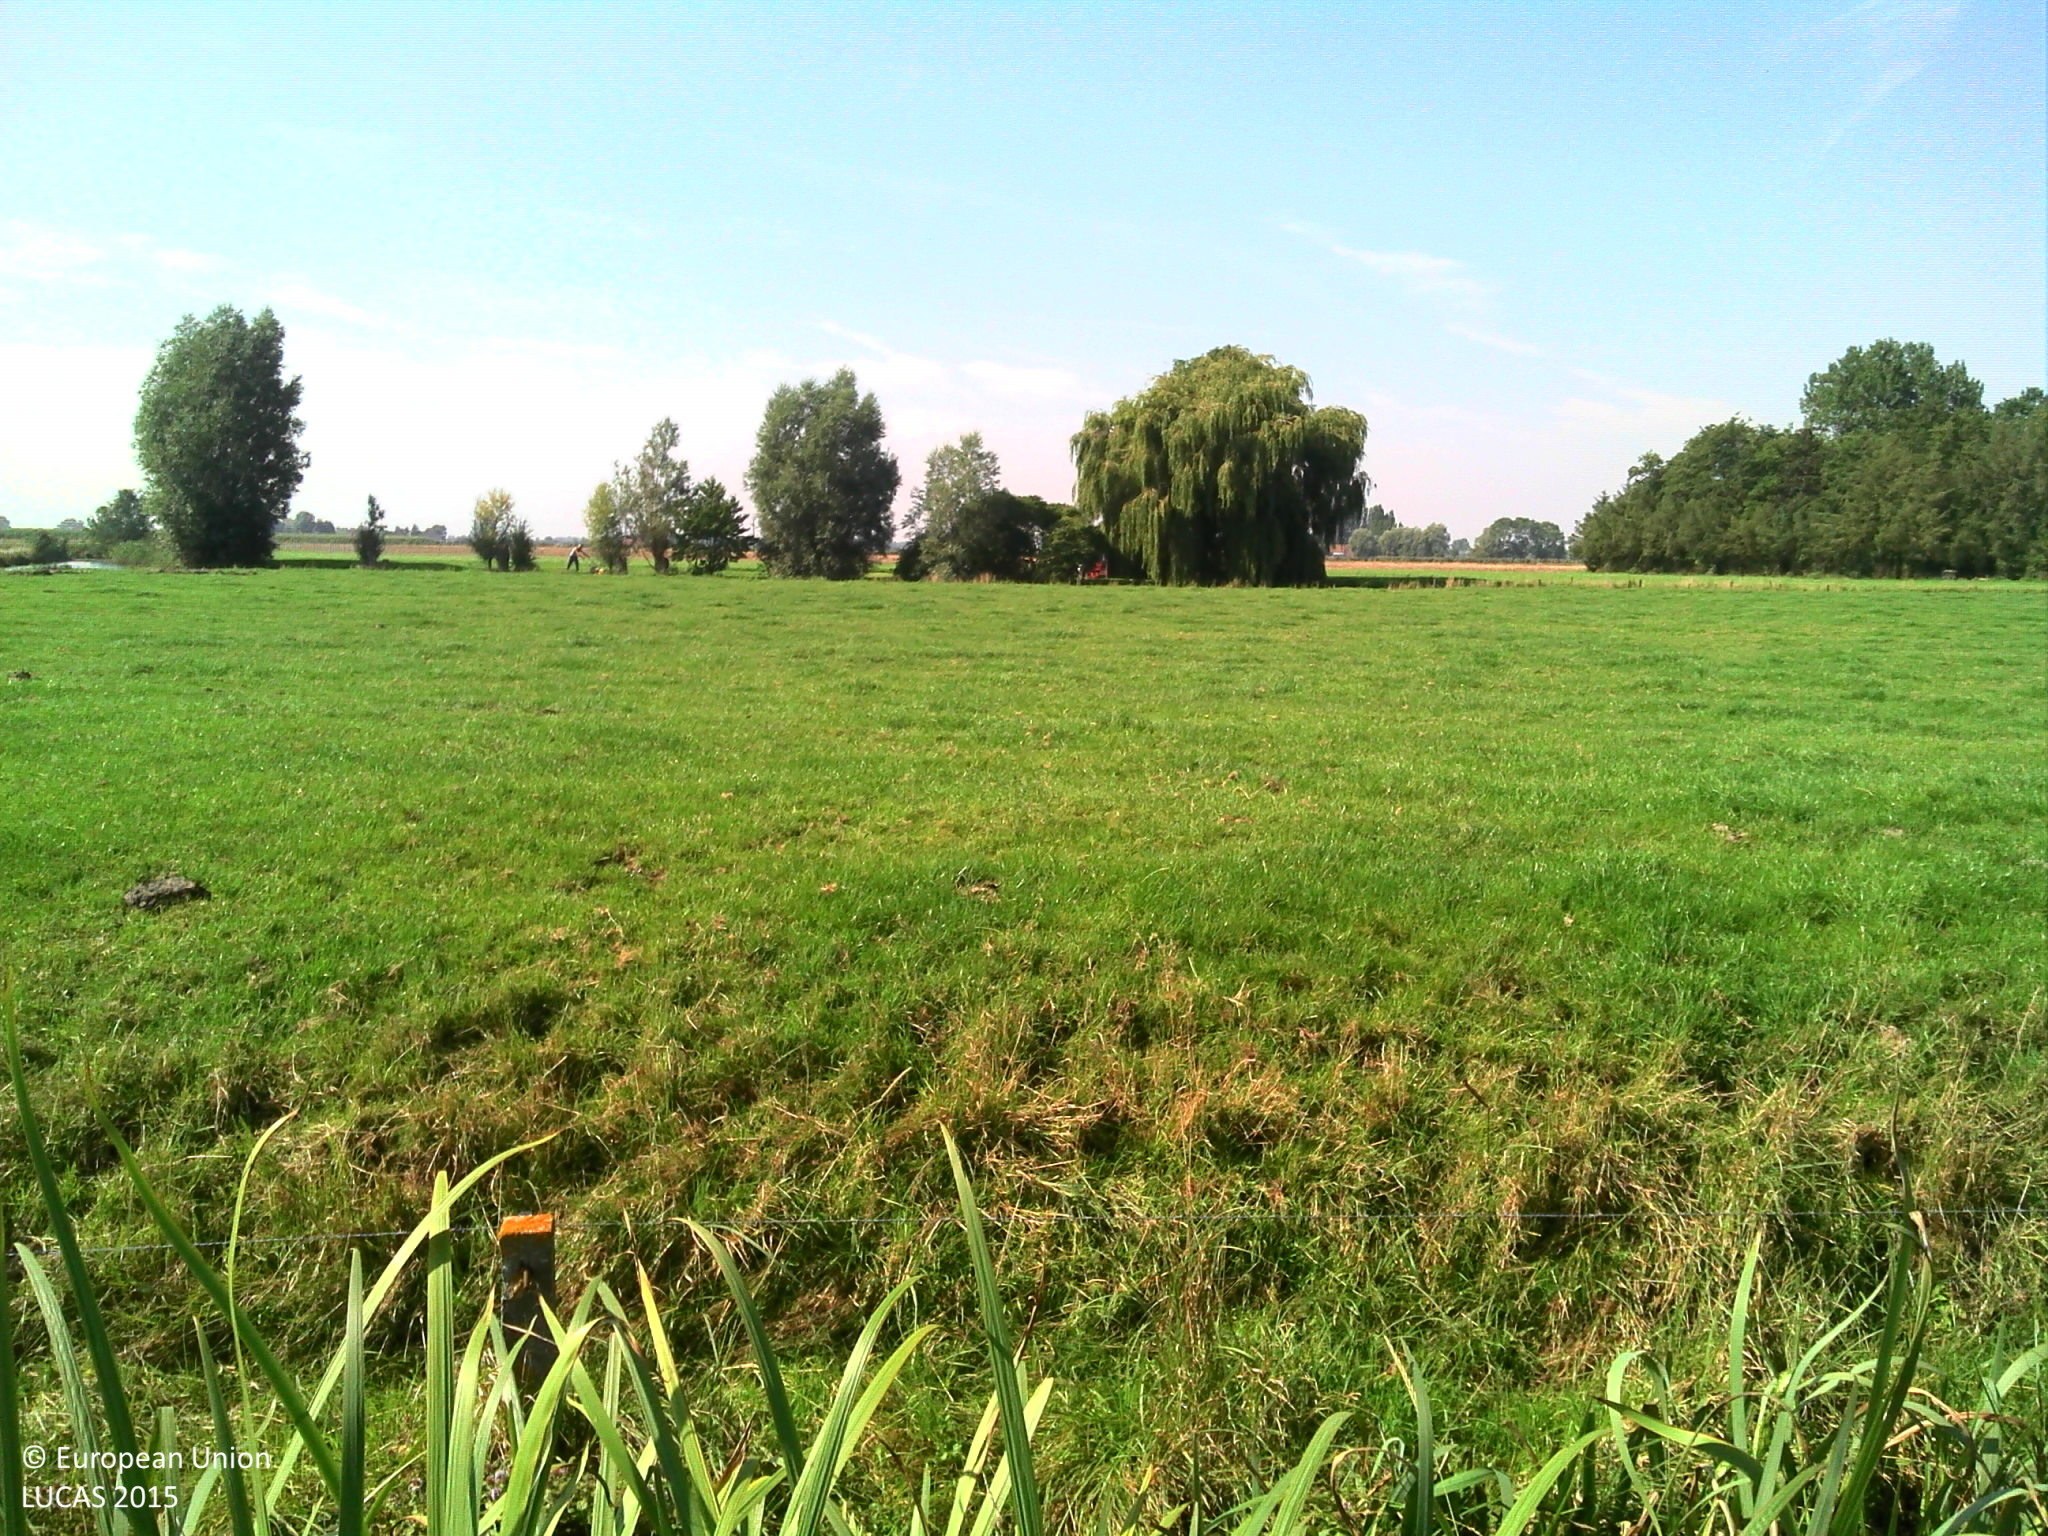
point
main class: Grassland
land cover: Grassland without tree/shrub cover
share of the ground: > 75 %
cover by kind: herbaceous plants 100 %
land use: Agriculture (excluding fallow land and kitchen gardens)
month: September
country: BE
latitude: 51.0031
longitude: 2.7922
